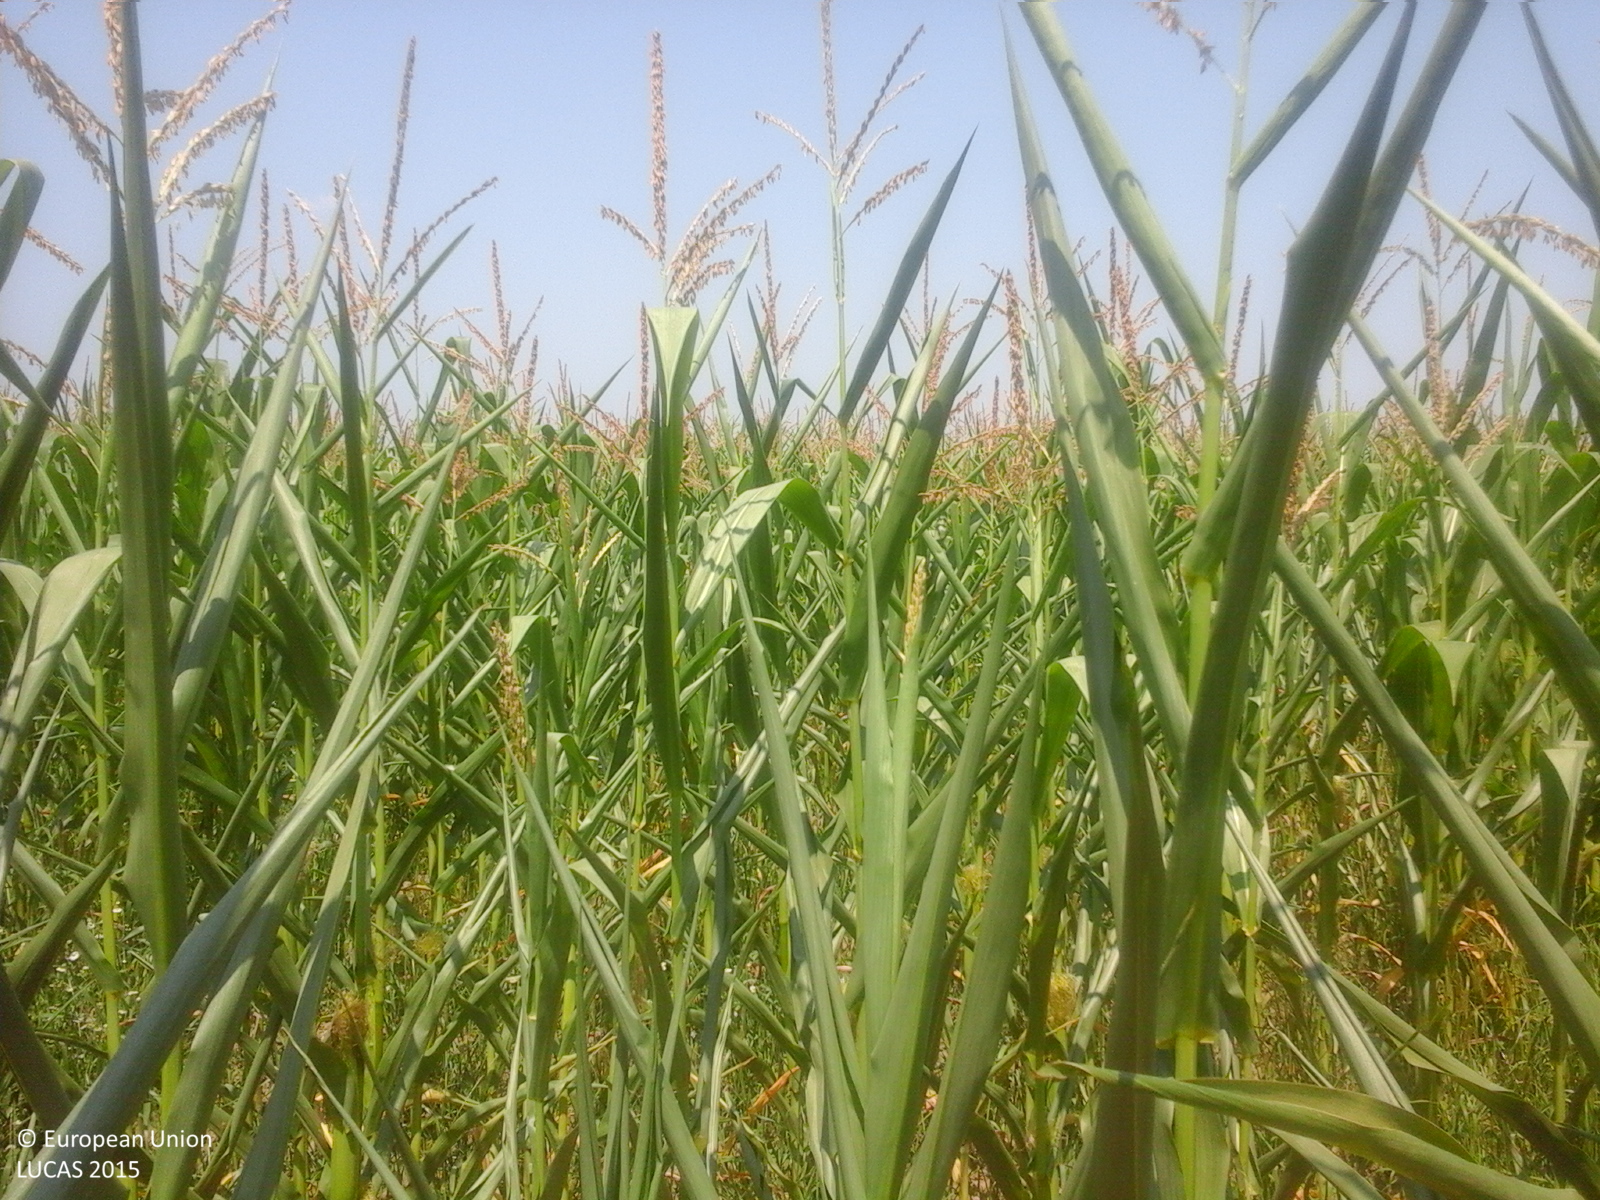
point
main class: Cropland
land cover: Maize
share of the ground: > 75 %
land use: Agriculture (excluding fallow land and kitchen gardens)
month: July
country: RO
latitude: 44.6777
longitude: 25.5226
